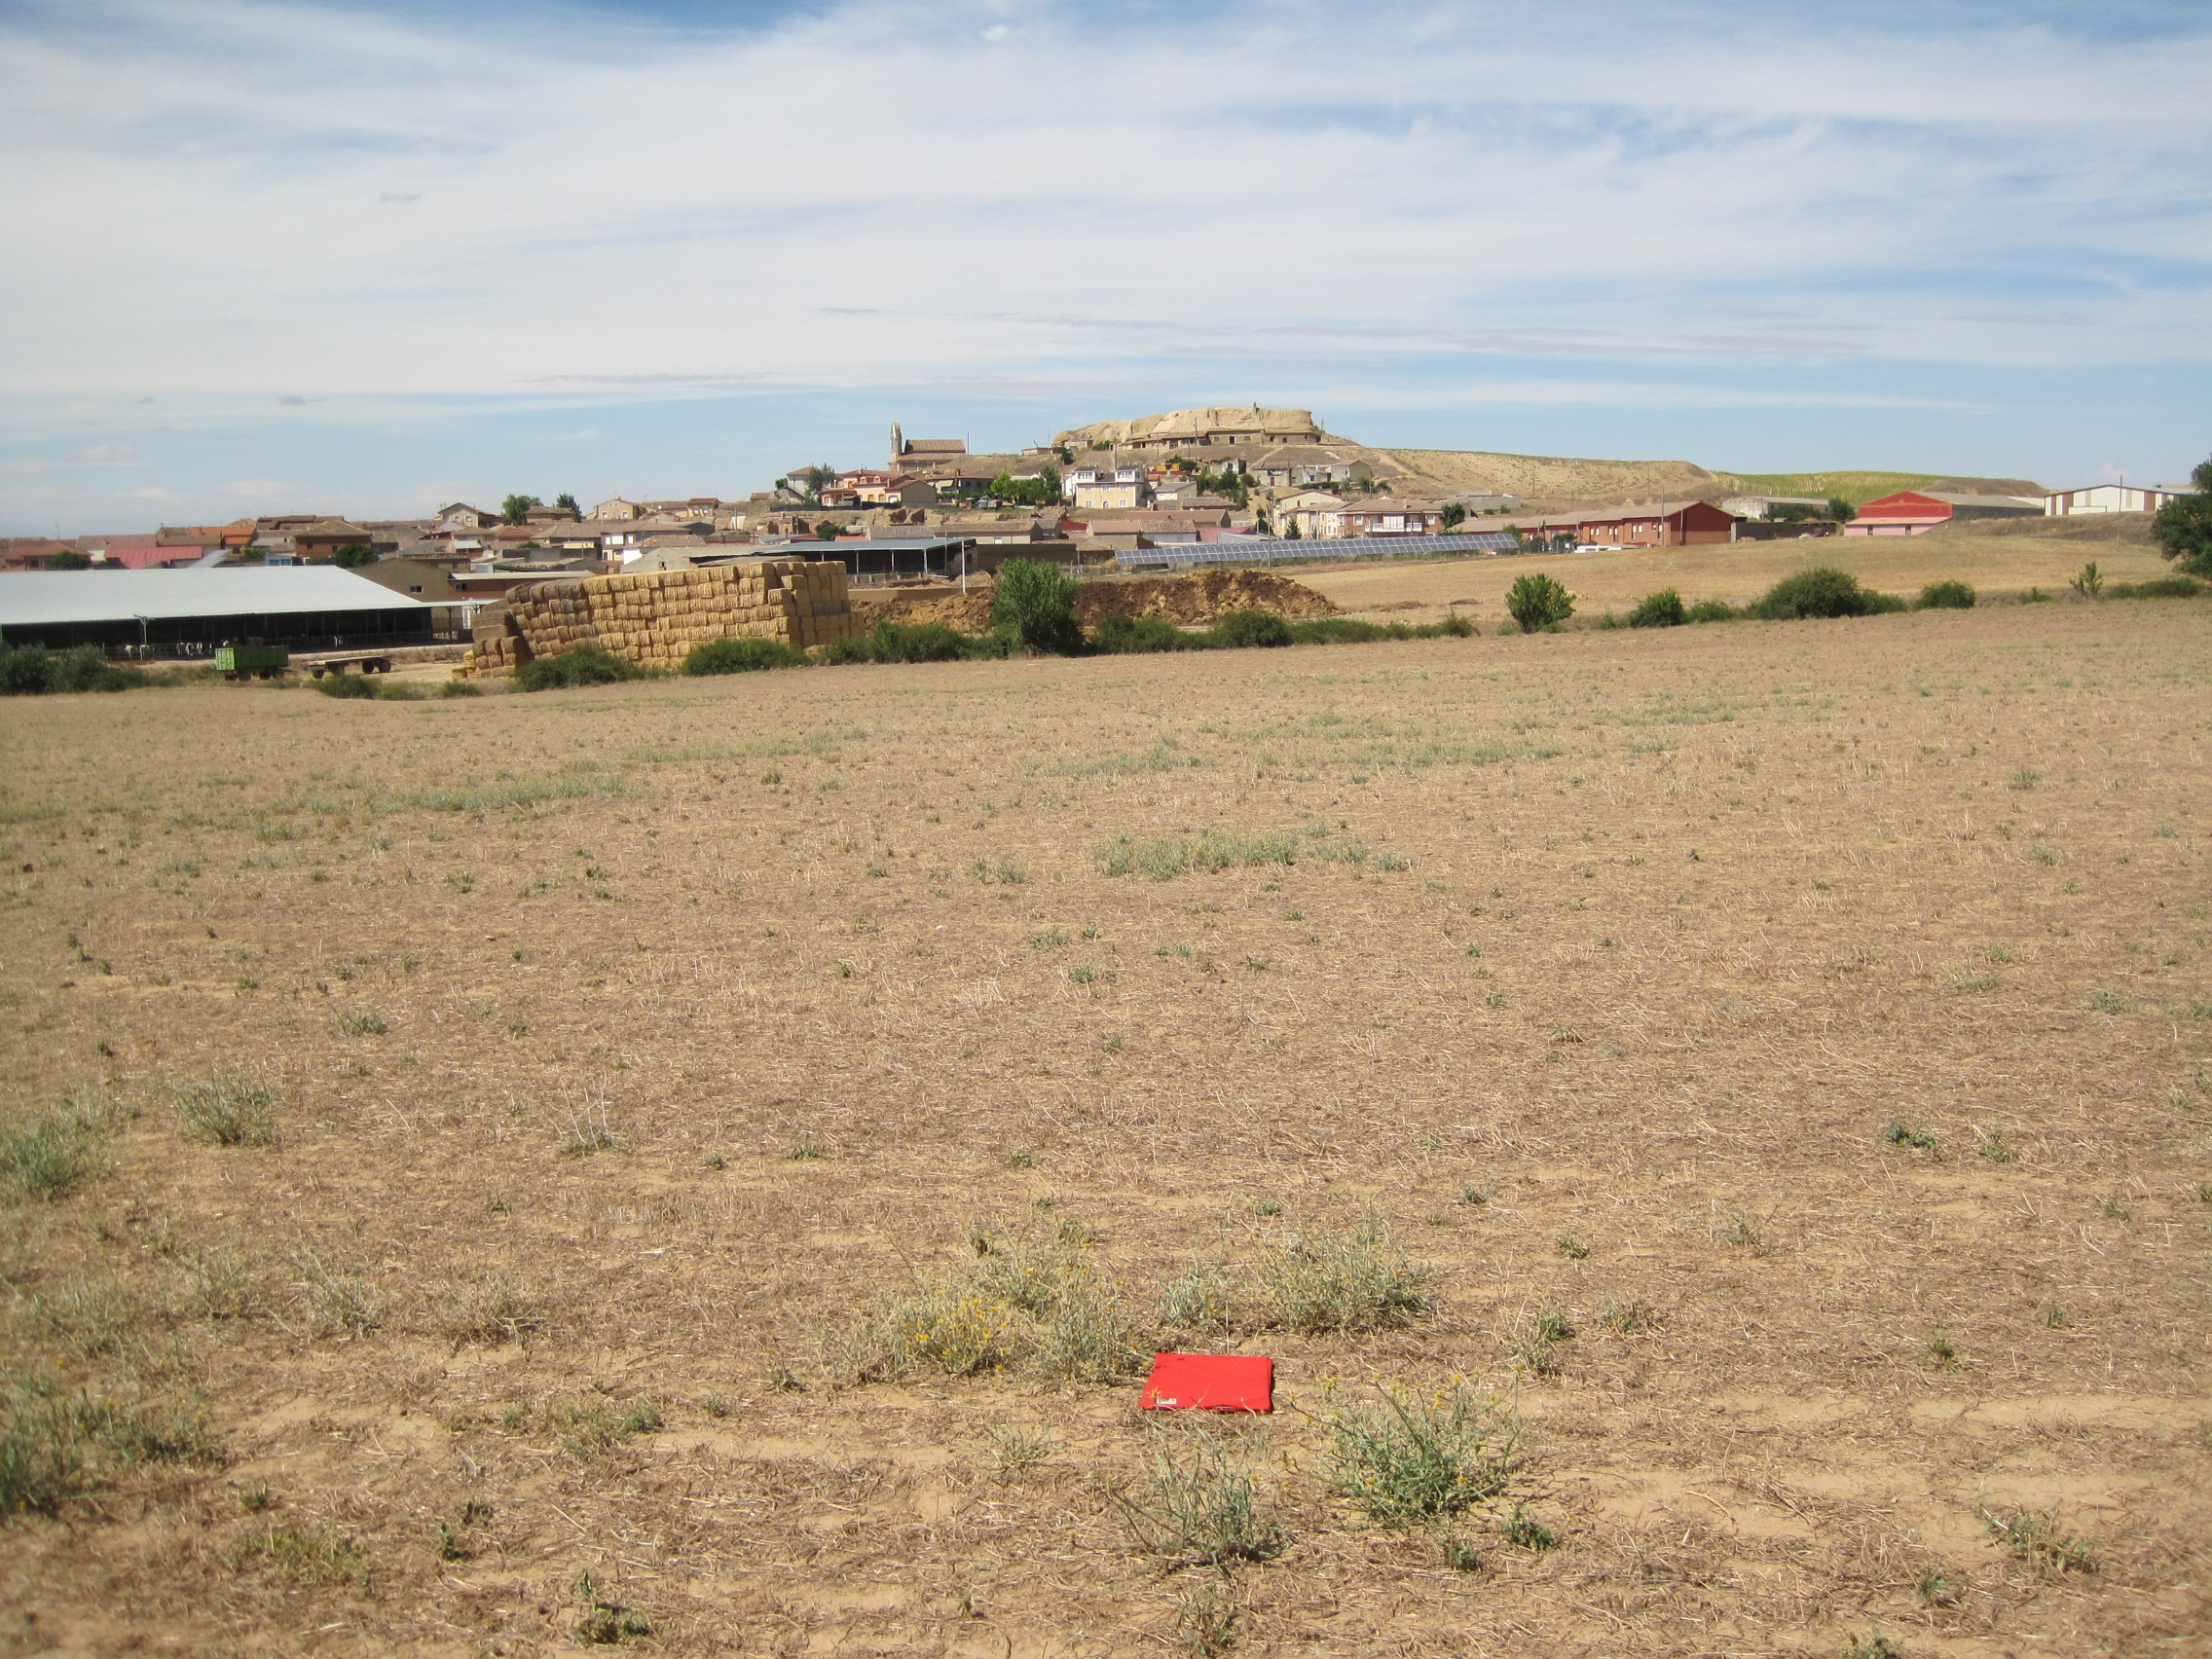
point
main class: Cropland
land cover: Dry pulses
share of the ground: < 10 %
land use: Agriculture (excluding fallow land and kitchen gardens)
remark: Harvested field
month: July
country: ES
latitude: 41.9792
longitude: -5.1797
